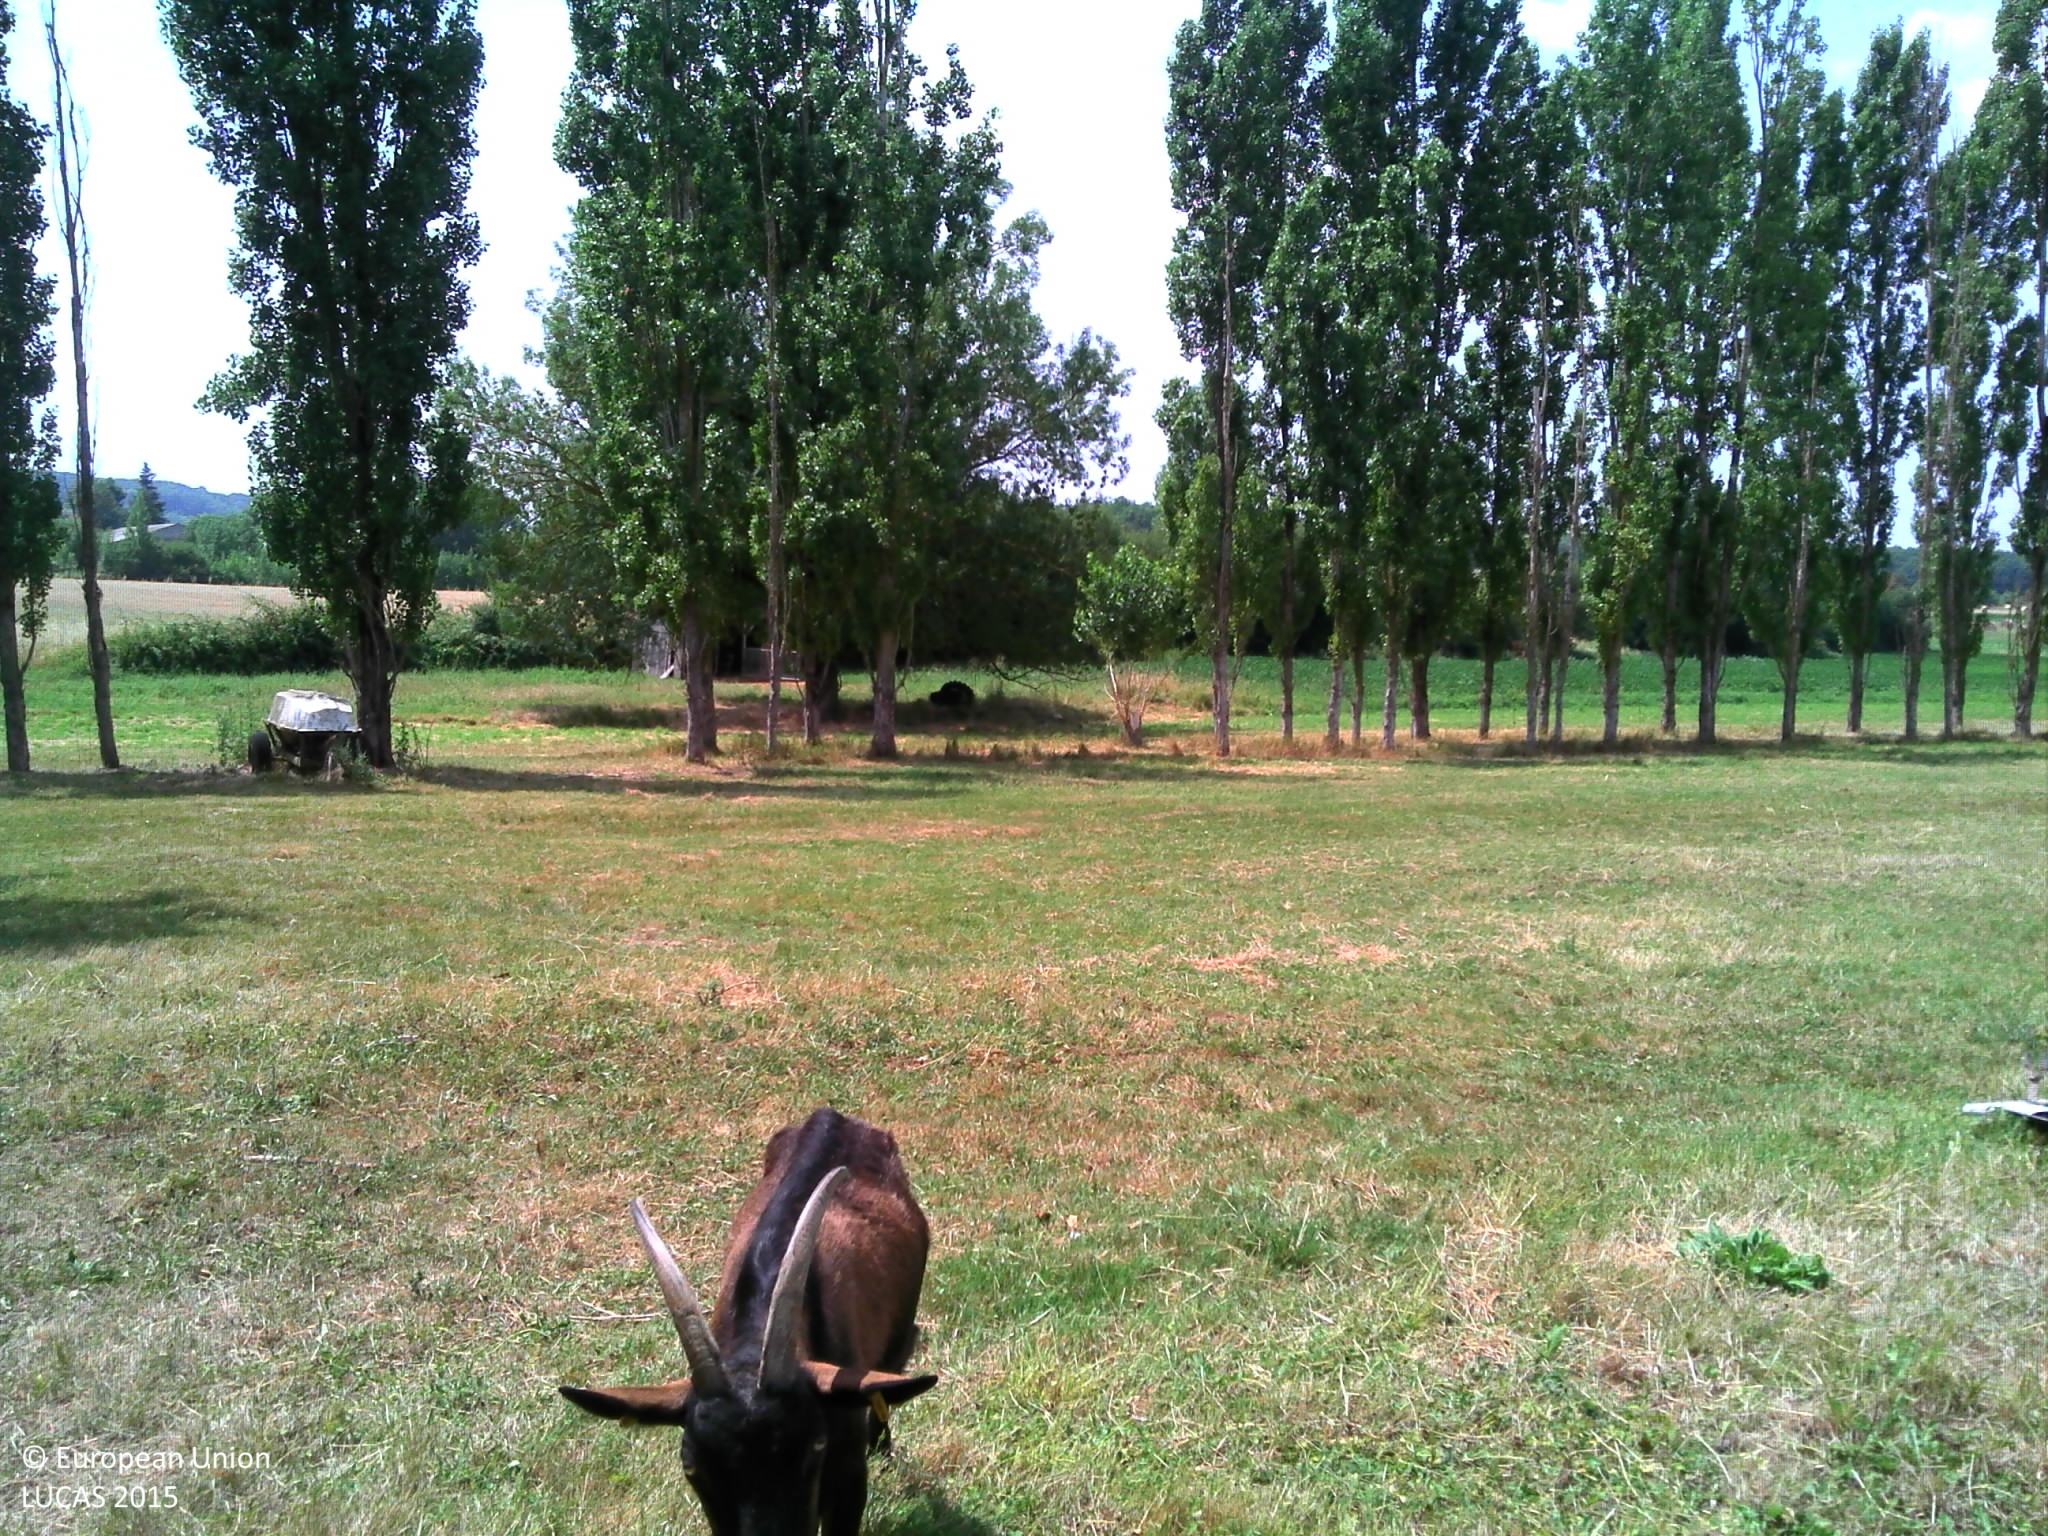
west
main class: Grassland
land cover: Grassland with sparse tree/shrub cover
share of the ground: > 75 %
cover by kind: herbaceous plants 95 %, coniferous forest trees 5 %
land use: Agriculture (excluding fallow land and kitchen gardens)
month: July
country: FR
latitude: 44.4028
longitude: 0.8921
